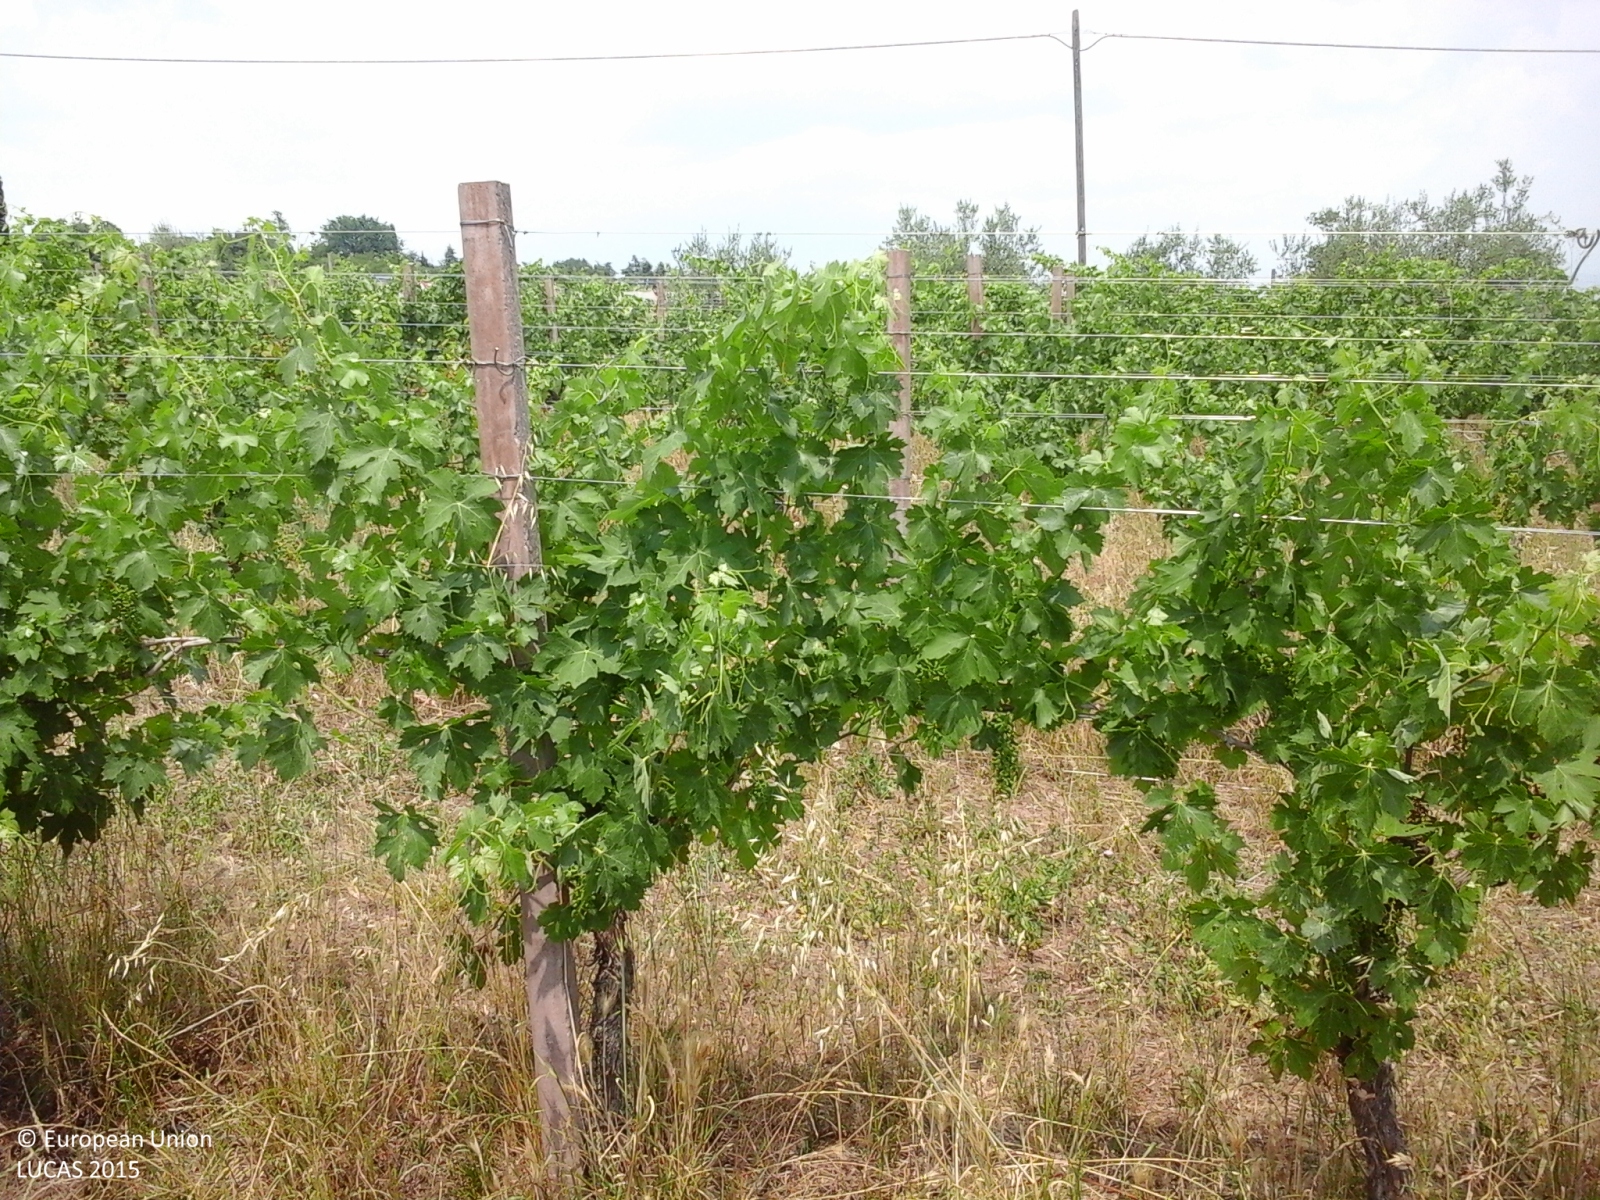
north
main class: Cropland
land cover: Vineyards
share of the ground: 25 - 50 %
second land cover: Grassland without tree/shrub cover
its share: > 75 %
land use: Agriculture (excluding fallow land and kitchen gardens)
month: June
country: IT
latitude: 45.3930
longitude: 10.8288
